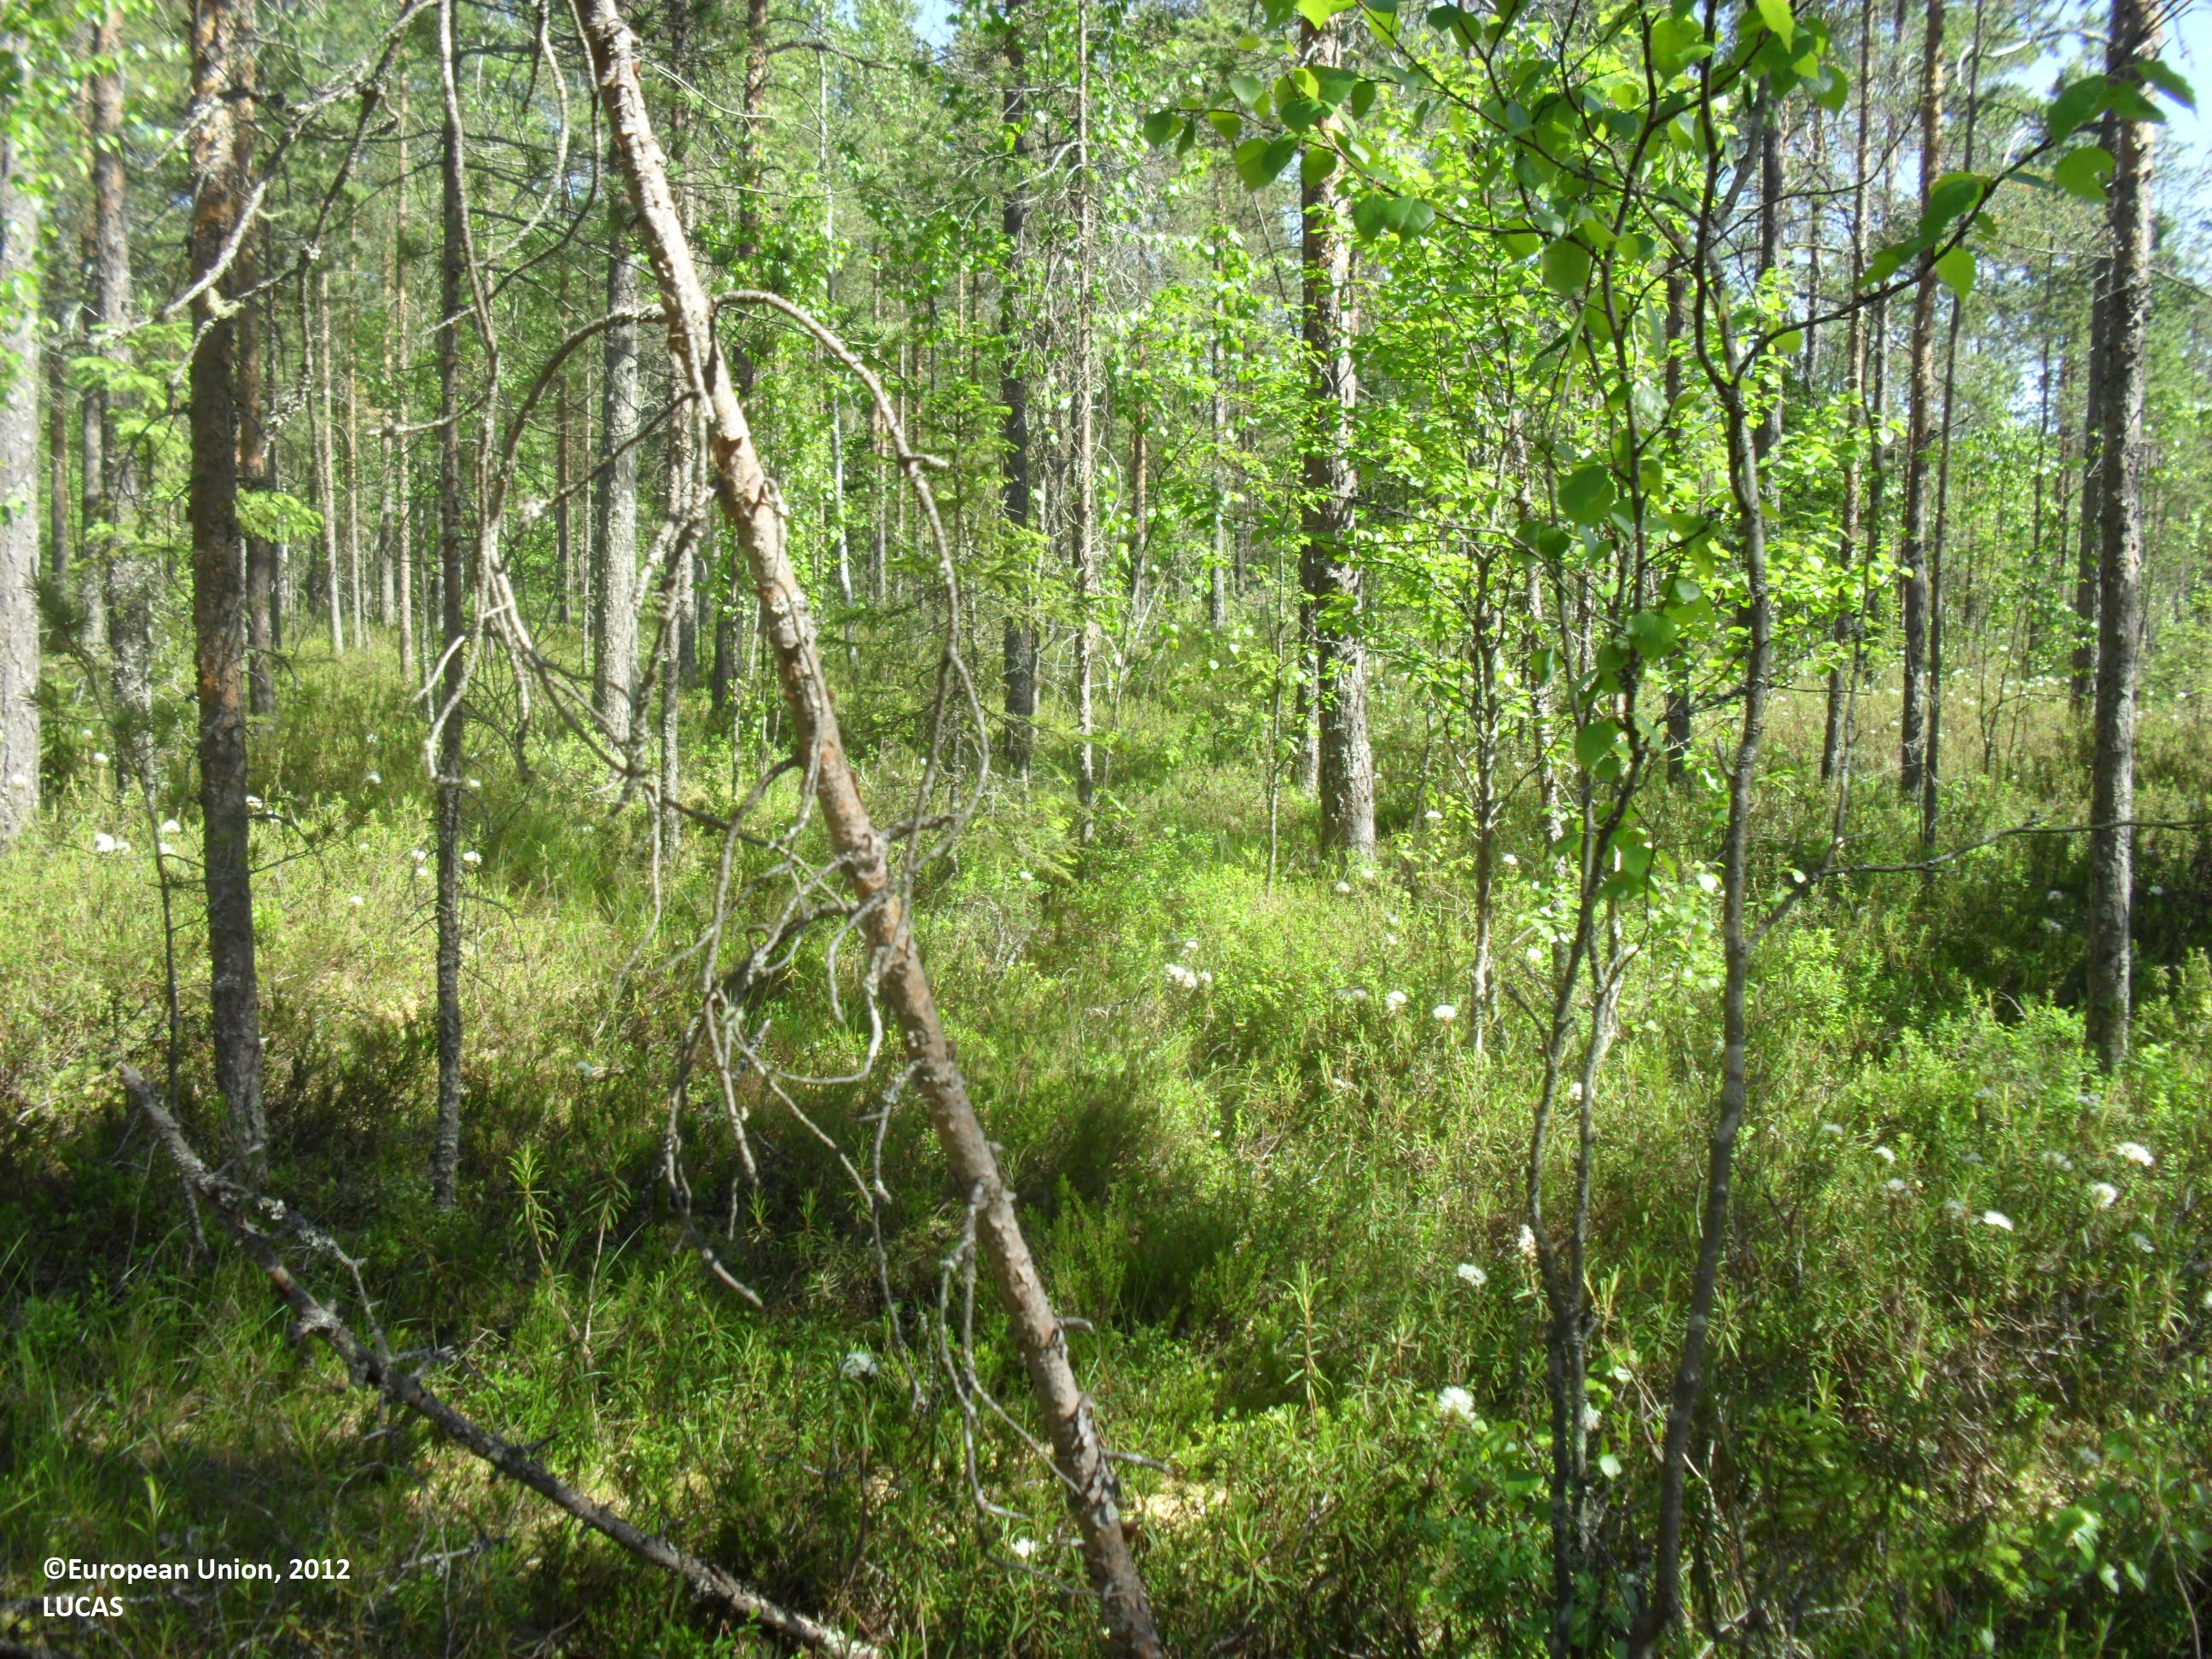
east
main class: Woodland
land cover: Pine dominated mixed woodland
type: boreal forest
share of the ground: 25 - 50 %
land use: Forestry
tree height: > 5 m
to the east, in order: Pine dominated mixed woodland; Other mixed woodland; Ditches and canals; Pine dominated mixed woodland; Rivers and streams; Pine dominated mixed woodland; Ditches and canals; Pine dominated mixed woodland; Other mixed woodland
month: June
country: FI
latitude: 63.1871
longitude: 23.1543
